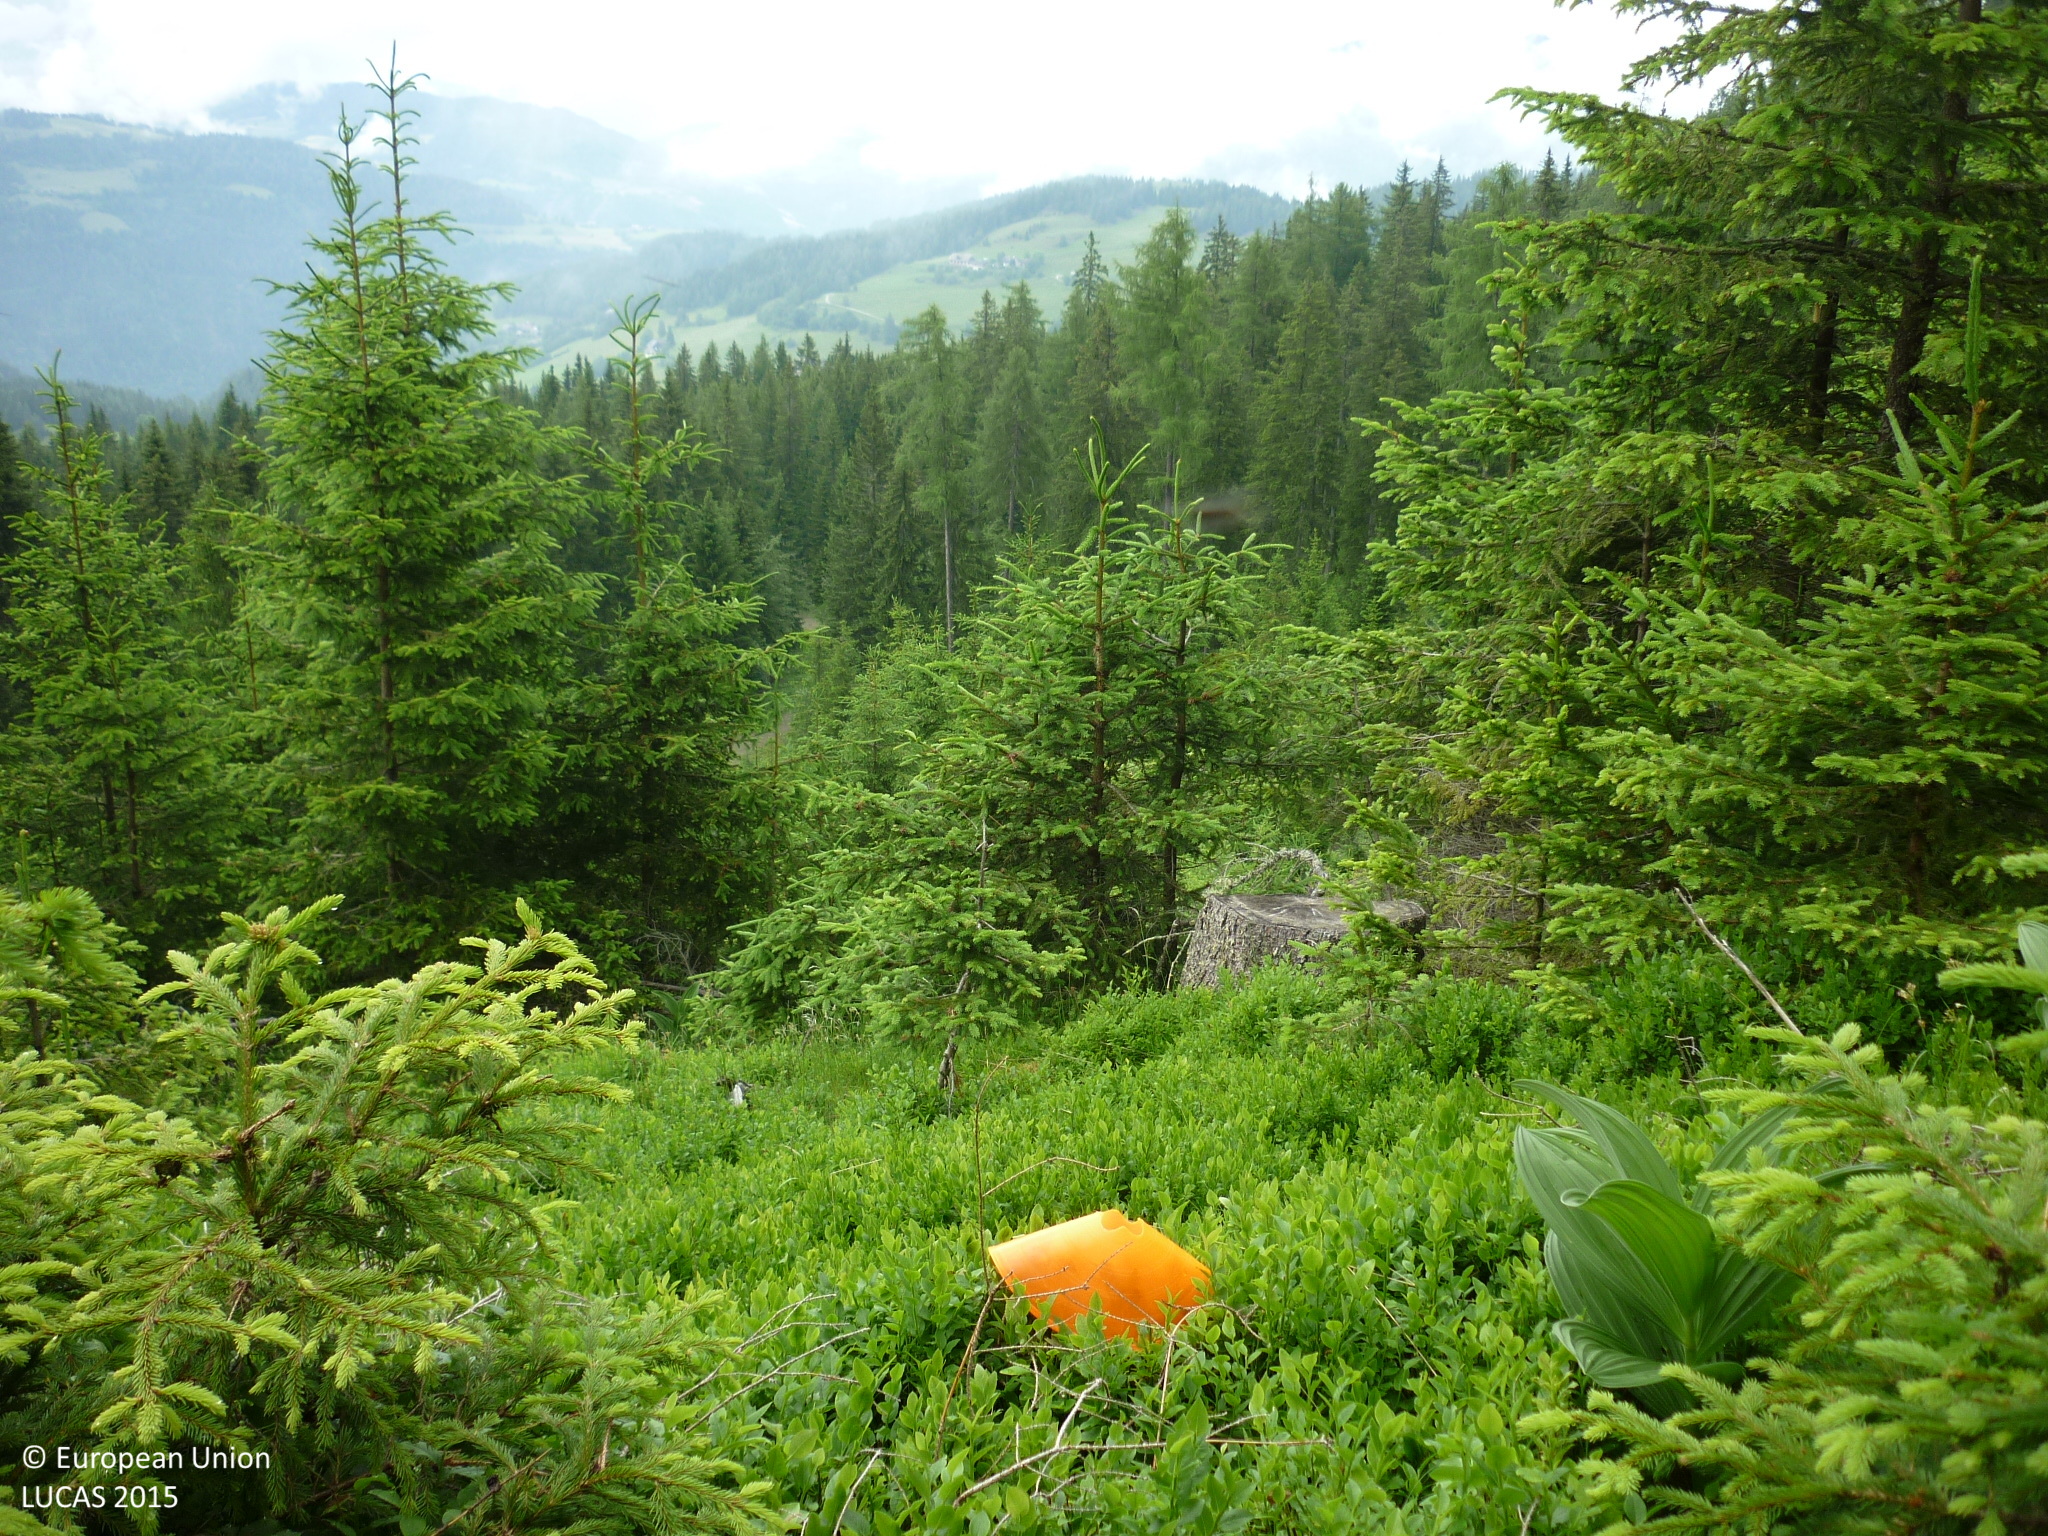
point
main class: Woodland
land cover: Spruce dominated coniferous woodland
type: alpine coniferous forest
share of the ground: 50 - 75 %
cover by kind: coniferous forest trees 70 %, shrubs 15 %, herbaceous plants 15 %
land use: Forestry
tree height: < 5 m
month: June
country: AT
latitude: 47.0961
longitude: 14.2537
